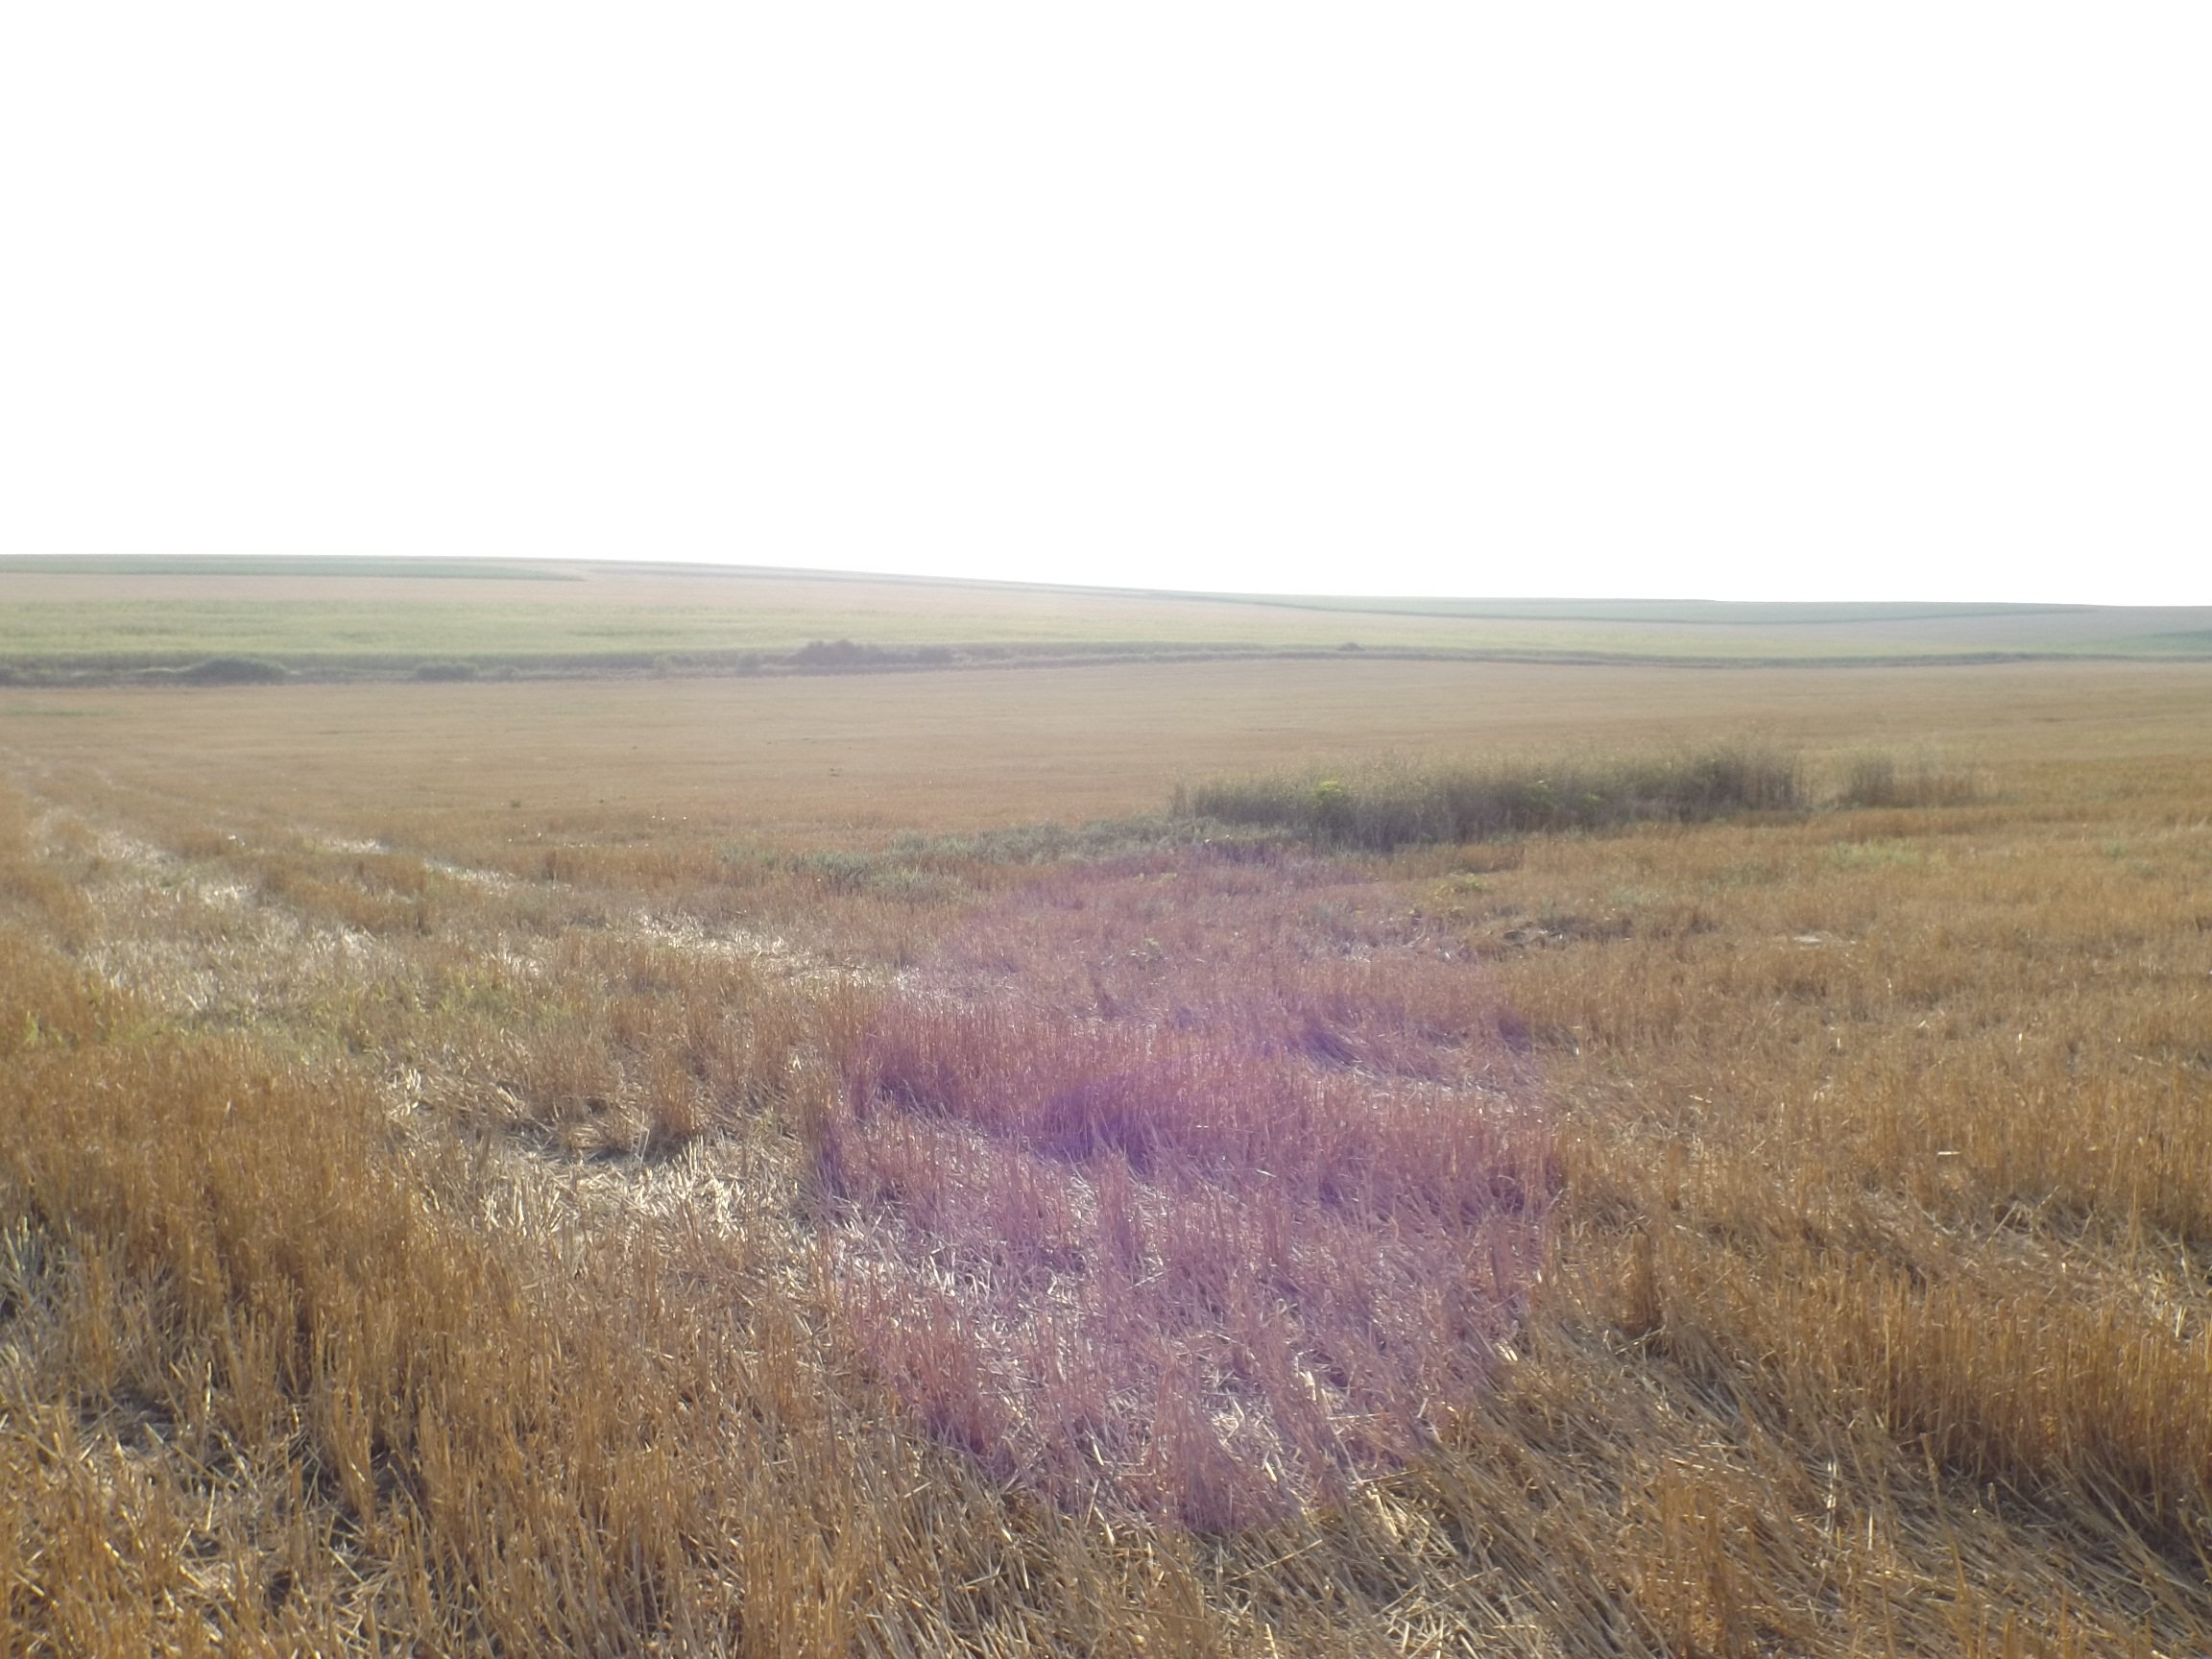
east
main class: Cropland
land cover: Common wheat
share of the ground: 10 - 25 %
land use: Agriculture (excluding fallow land and kitchen gardens)
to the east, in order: Common wheat; Grass margins; Tracks
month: July
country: BG
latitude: 43.5665
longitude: 27.4007
